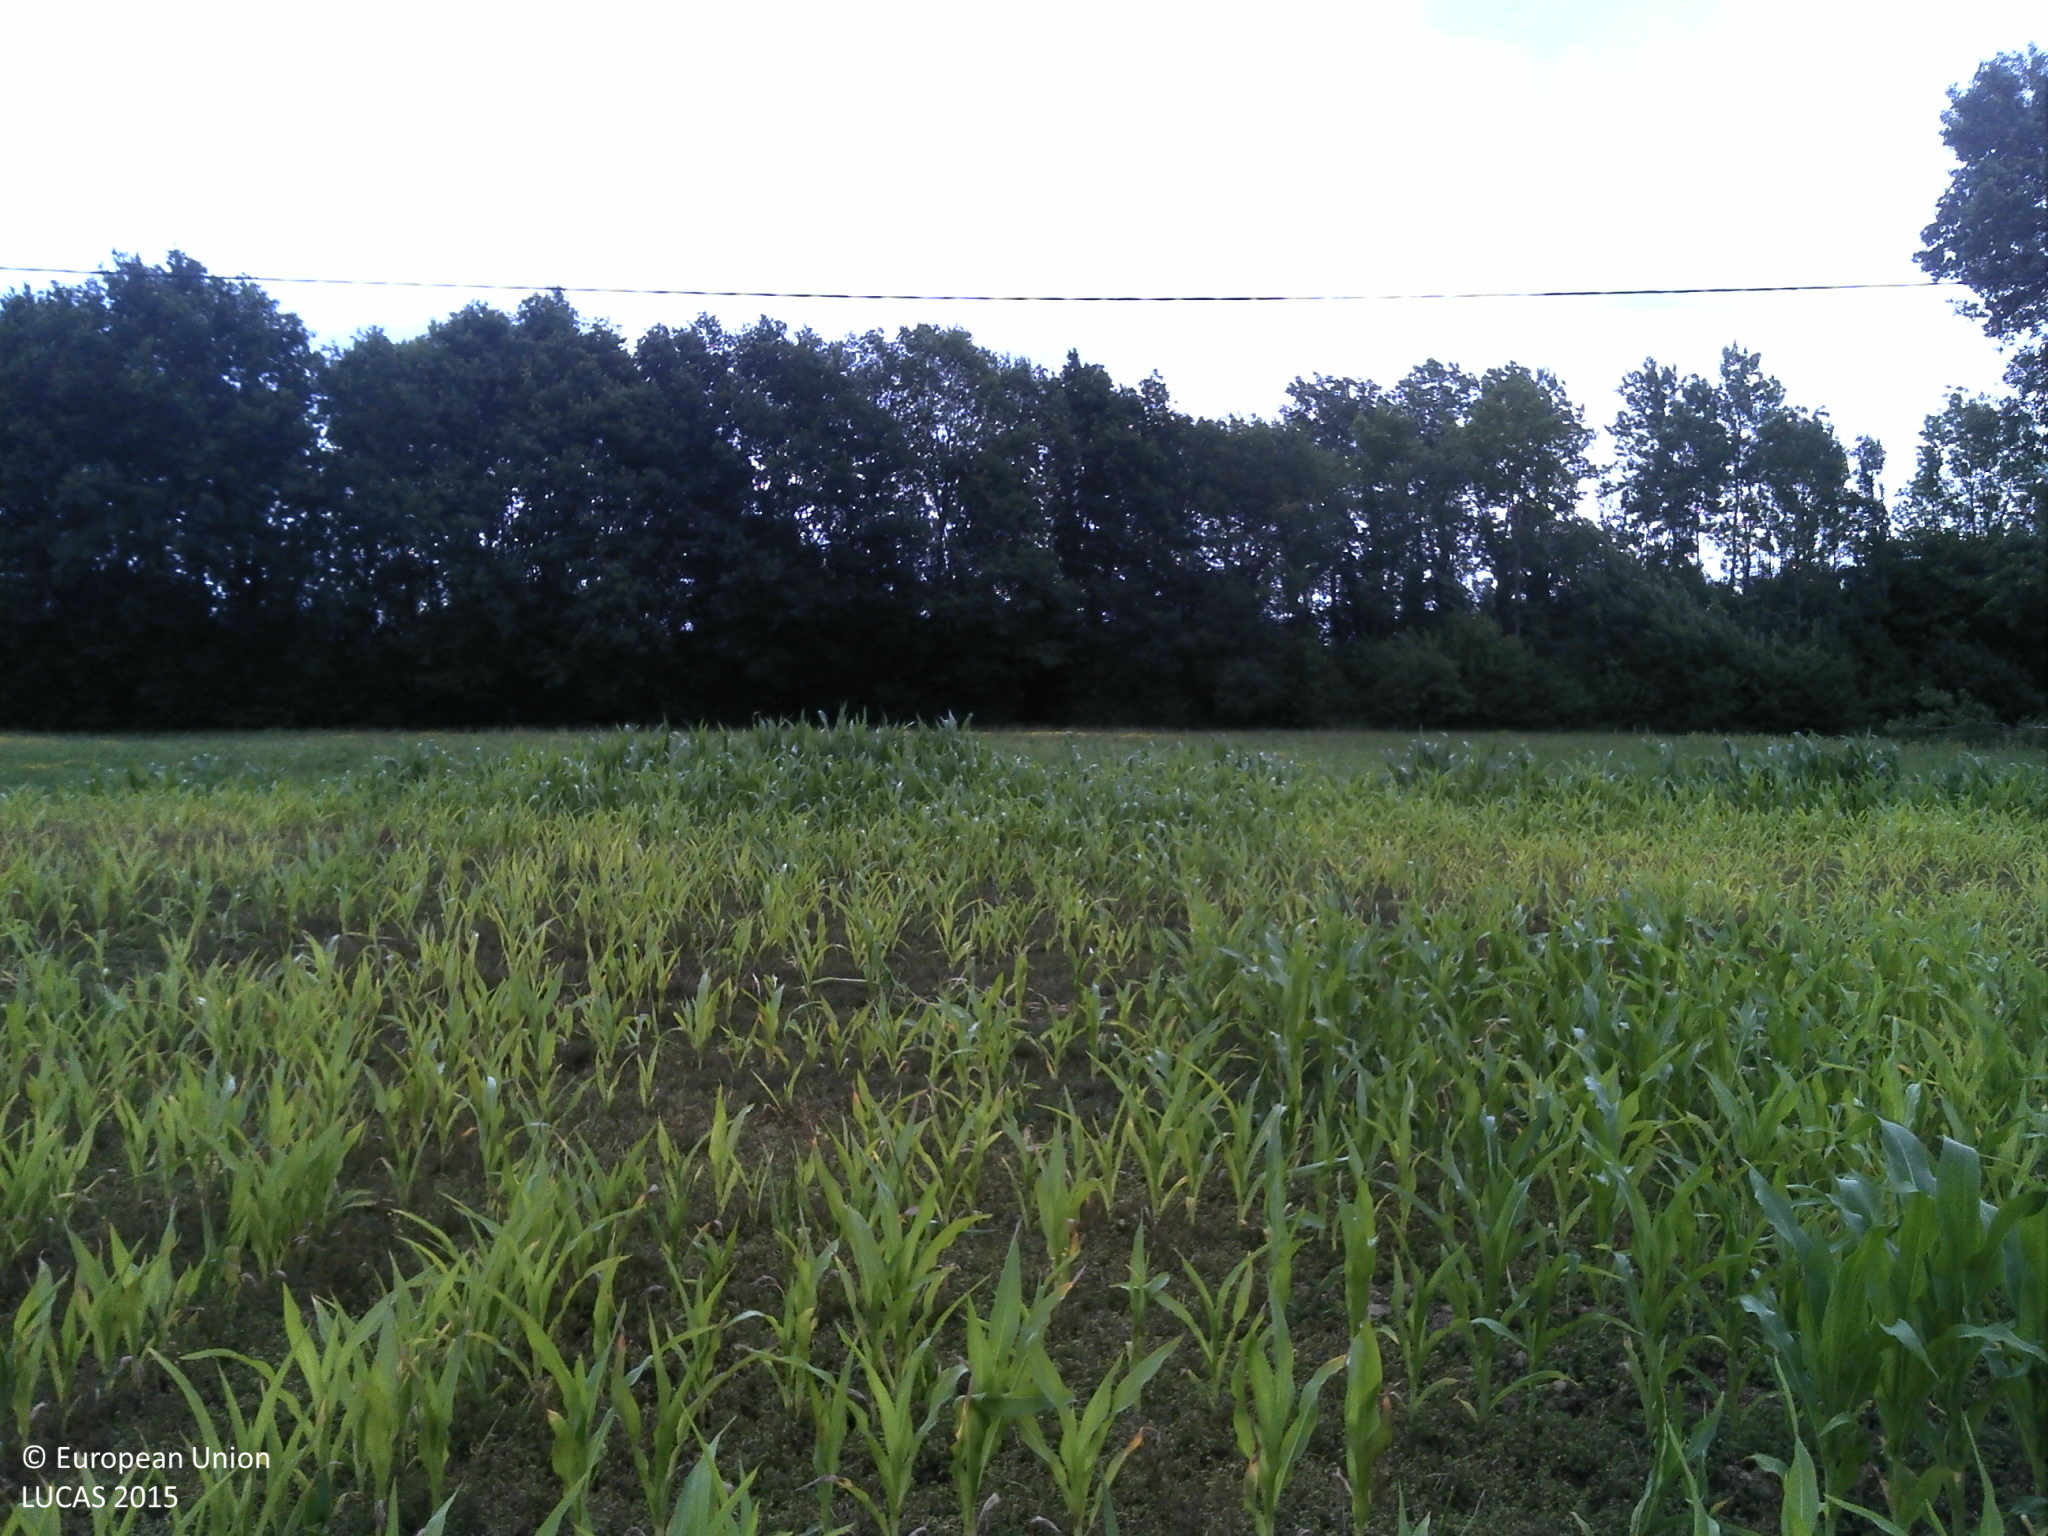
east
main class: Cropland
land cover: Maize
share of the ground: 25 - 50 %
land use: Agriculture (excluding fallow land and kitchen gardens)
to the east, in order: Maize; Electric lines; Ditches and canals; Paved roads, cycling and walking lanes; Ditches and canals; Grassland without tree/shrub cover; Broadleaved woodland; Tracks; Broadleaved woodland; Fences; Grassland without tree/shrub cover; Fences; Broadleaved woodland; Fences; Grassland without tree/shrub cover
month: July
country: FR
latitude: 49.8036
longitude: 4.5914
